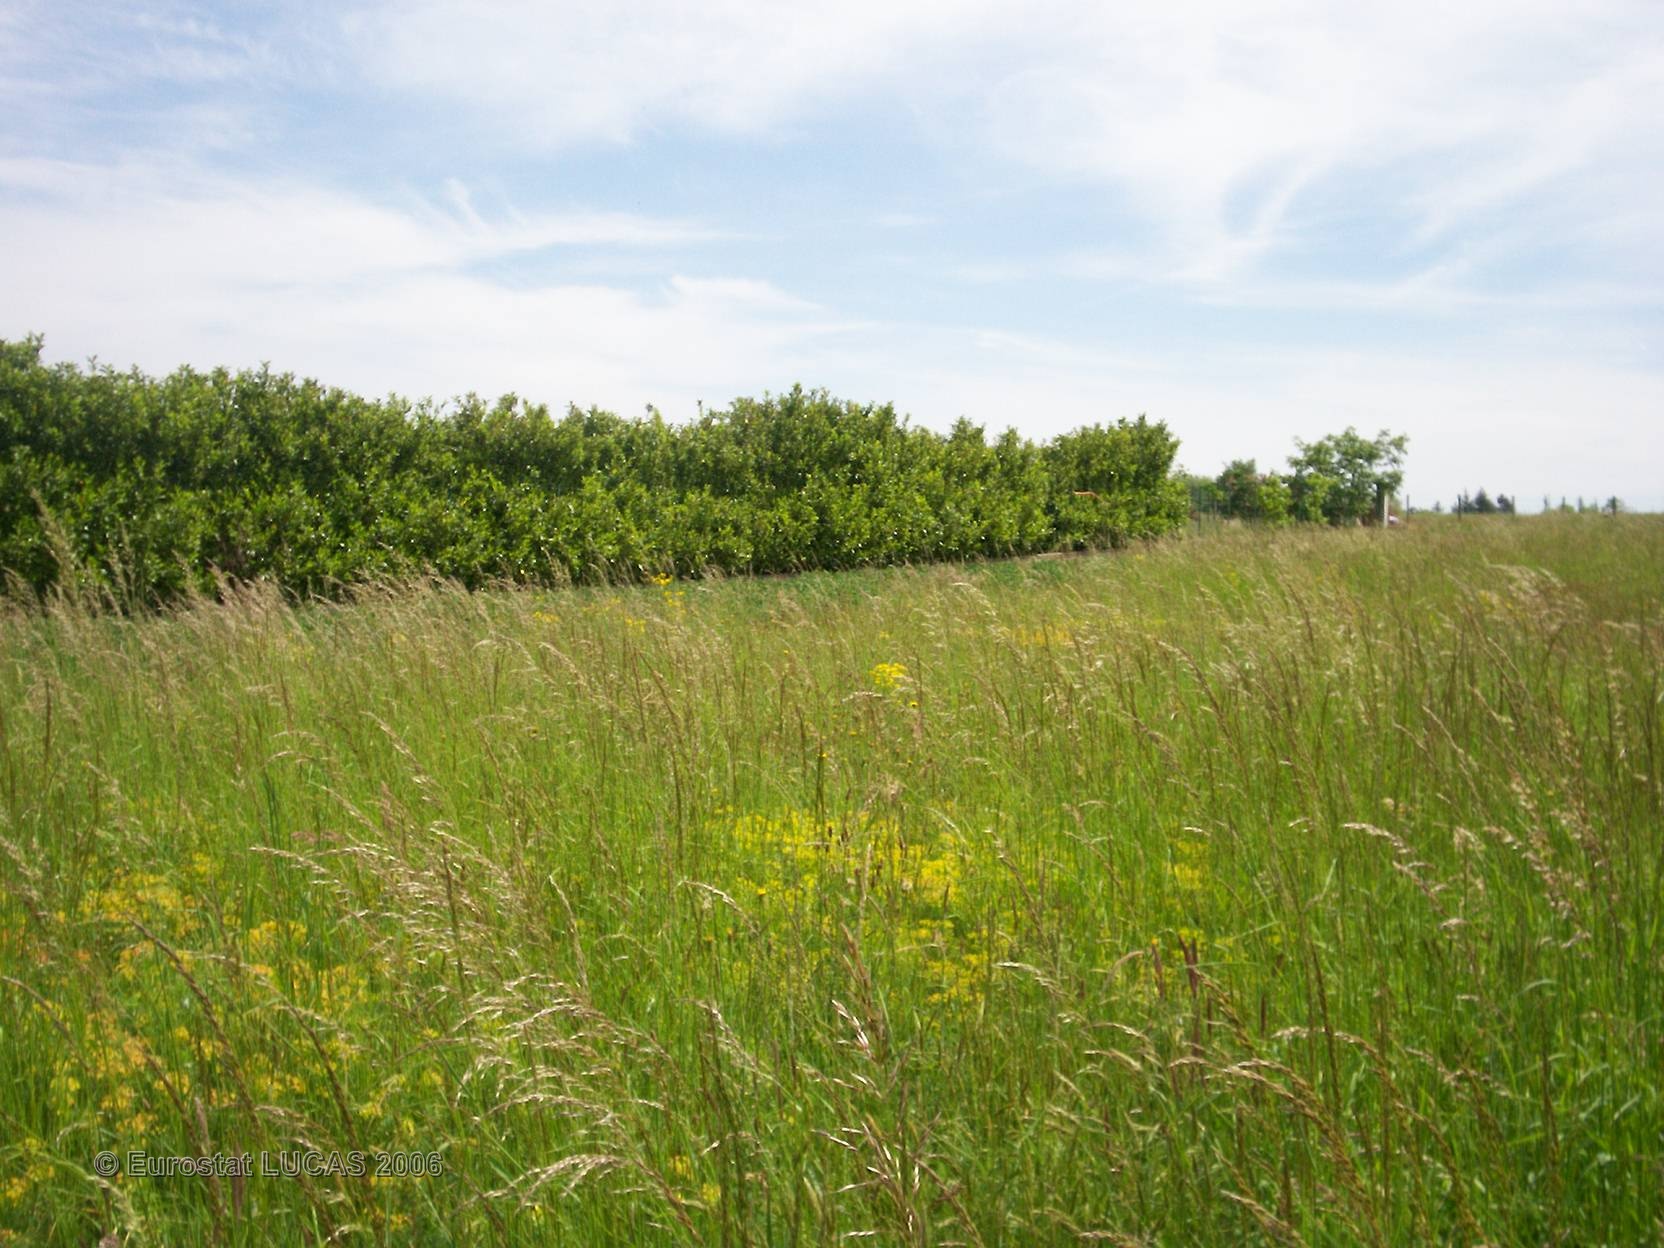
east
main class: Grassland
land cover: Grassland without tree/shrub cover
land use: Agriculture (excluding fallow land and kitchen gardens)
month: May
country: FR
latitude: 45.7001
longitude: 4.7764
